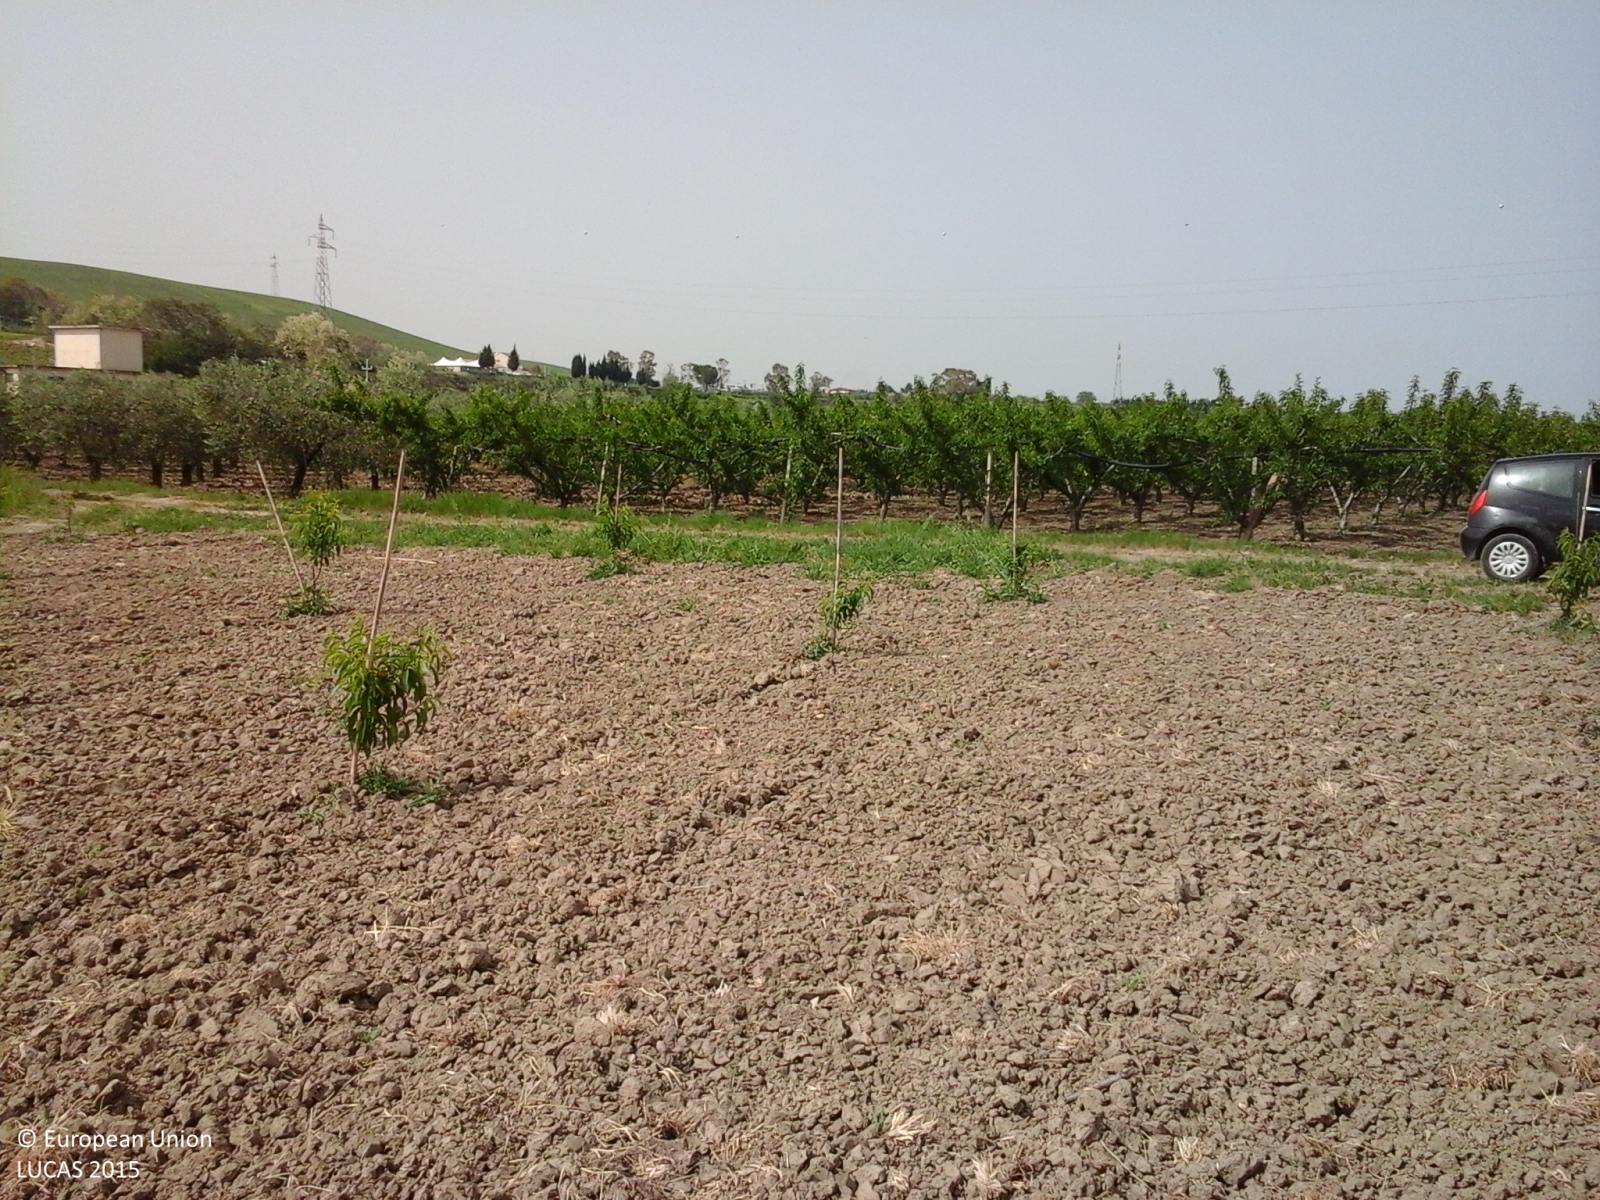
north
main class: Cropland
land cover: Other fruit trees and berries
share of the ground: 25 - 50 %
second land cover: Other bare soil
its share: > 75 %
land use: Agriculture (excluding fallow land and kitchen gardens)
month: May
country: IT
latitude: 42.0188
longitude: 14.7313
